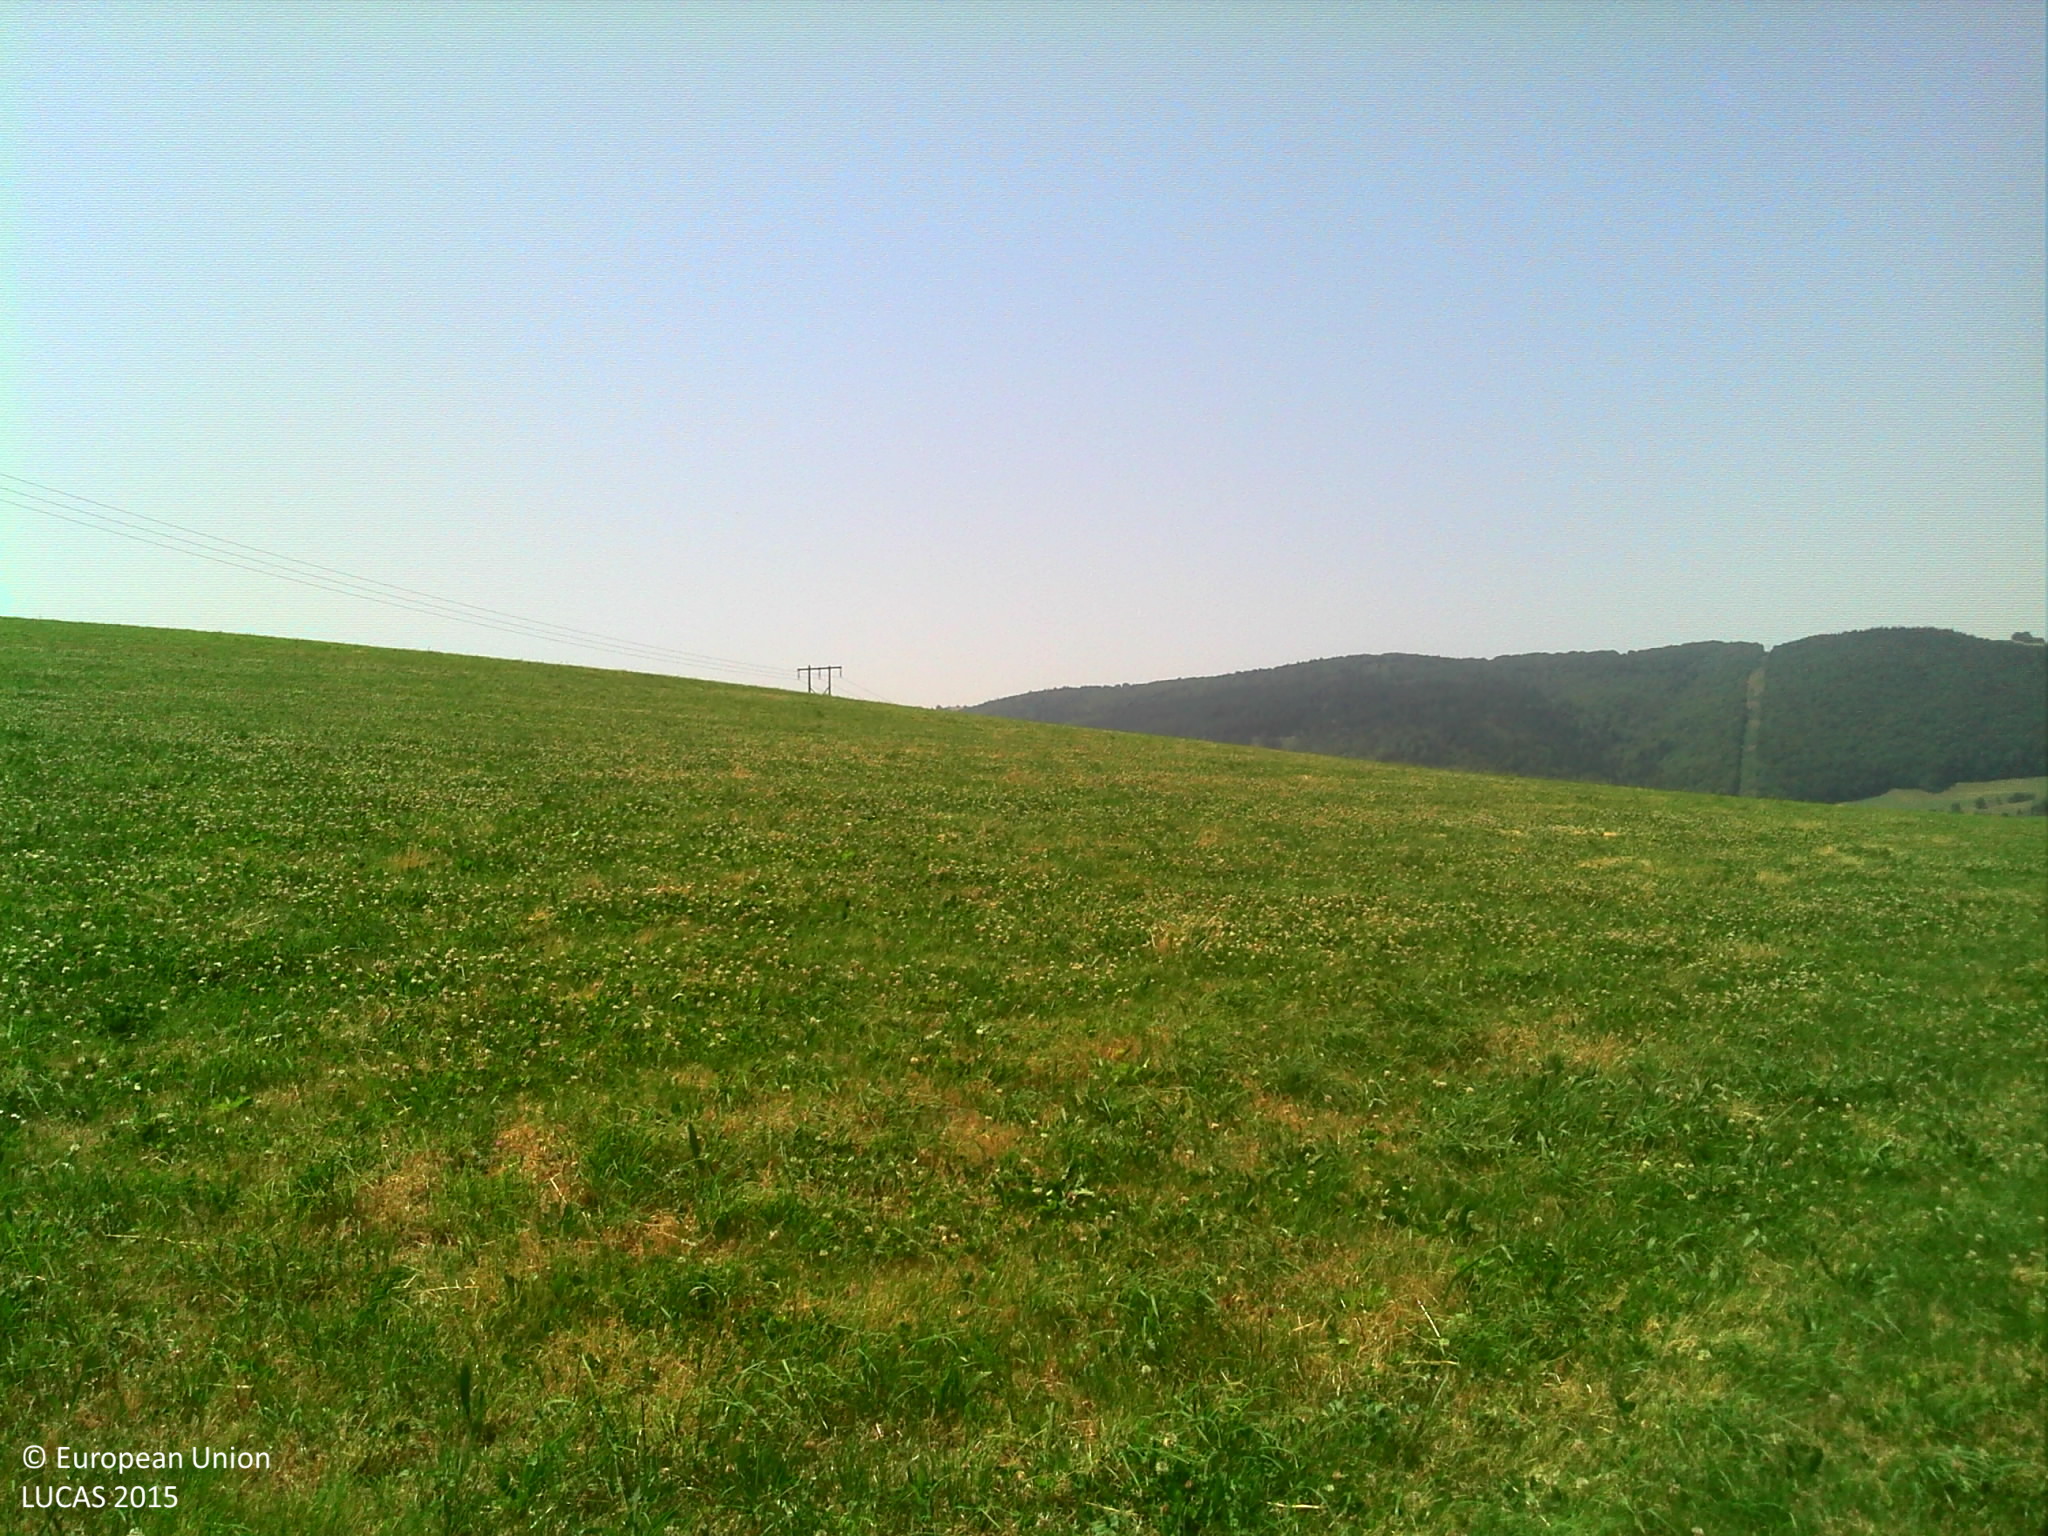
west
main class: Grassland
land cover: Grassland without tree/shrub cover
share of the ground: > 75 %
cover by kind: herbaceous plants 100 %
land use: Agriculture (excluding fallow land and kitchen gardens)
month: July
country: FR
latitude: 46.1039
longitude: 6.2132
